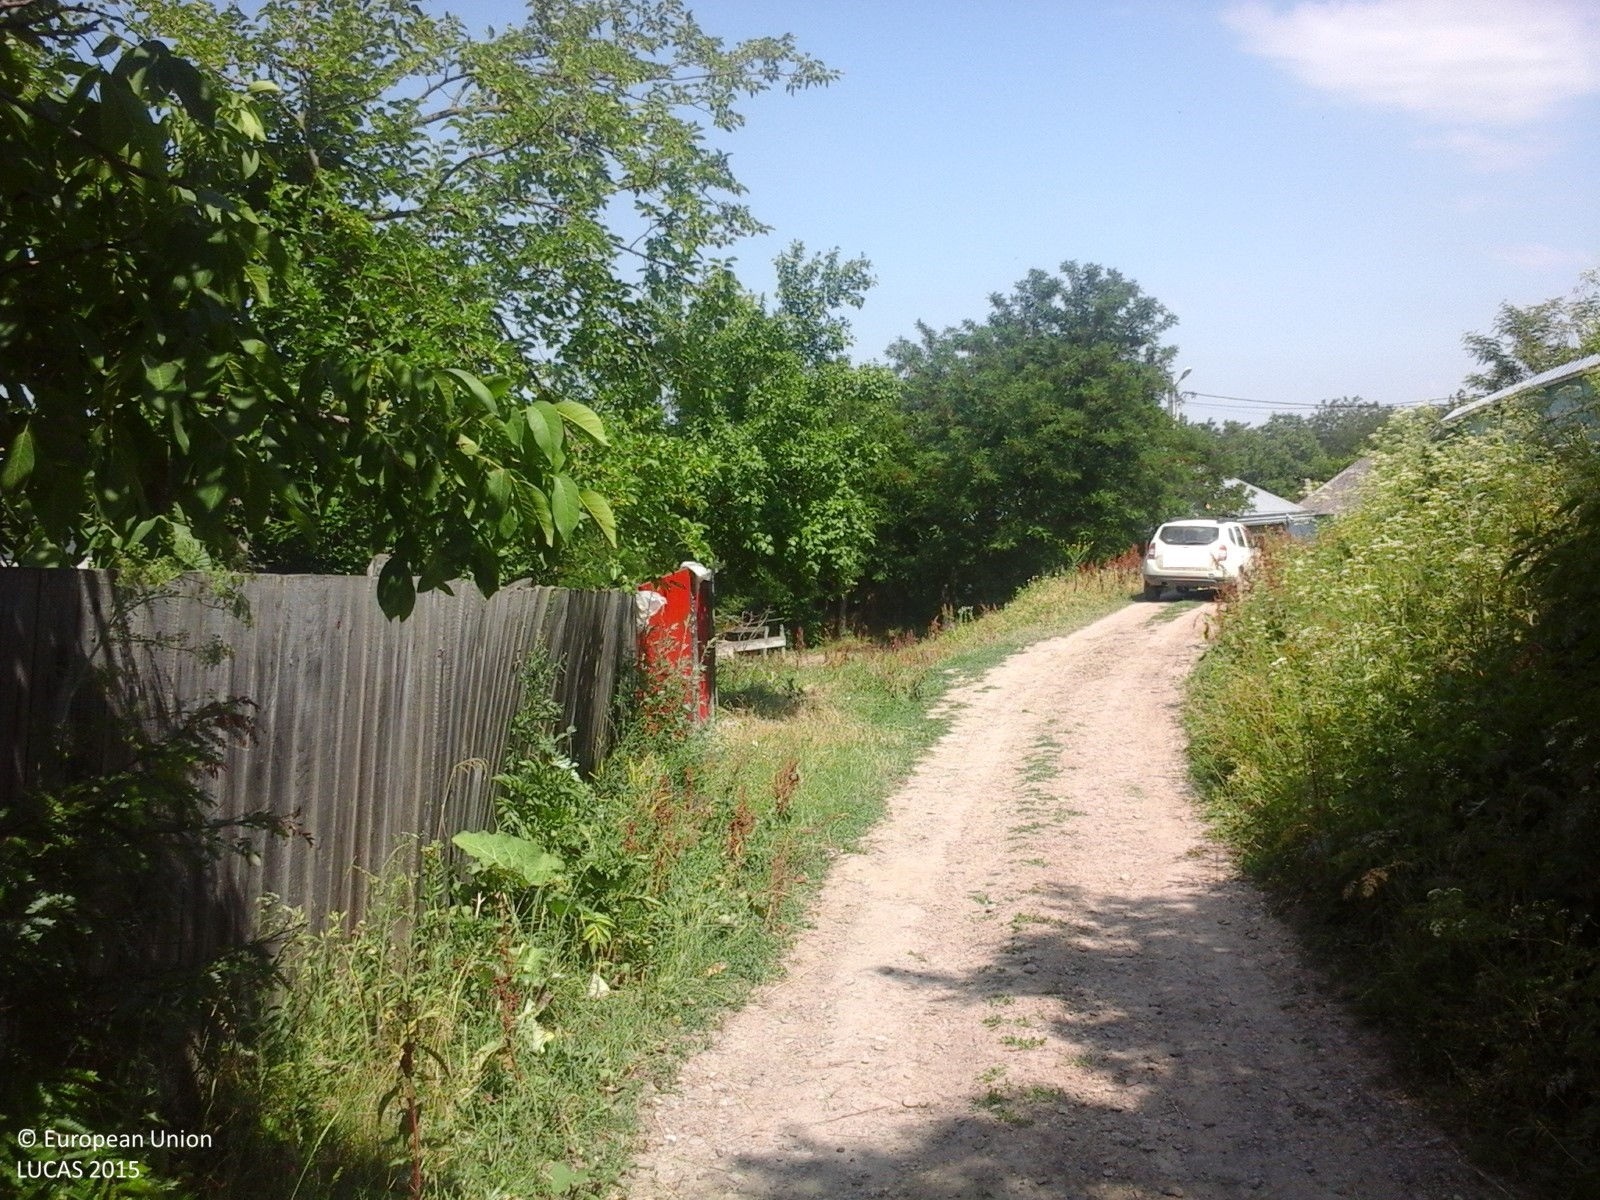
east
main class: Shrubland
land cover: Shrubland with sparse tree cover
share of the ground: > 75 %
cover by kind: shrubs 95 %, broadleaved forest trees 5 %
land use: Semi-natural and natural areas not in use
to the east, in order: Shrubland with sparse tree cover; Artificial constructions in urban areas; Spontaneously vegetated surfaces; Artificial constructions in urban areas; Maize; Artificial constructions in urban areas; Ditches and canals; Artificial constructions in urban areas
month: June
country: RO
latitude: 46.7074
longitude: 27.3337
